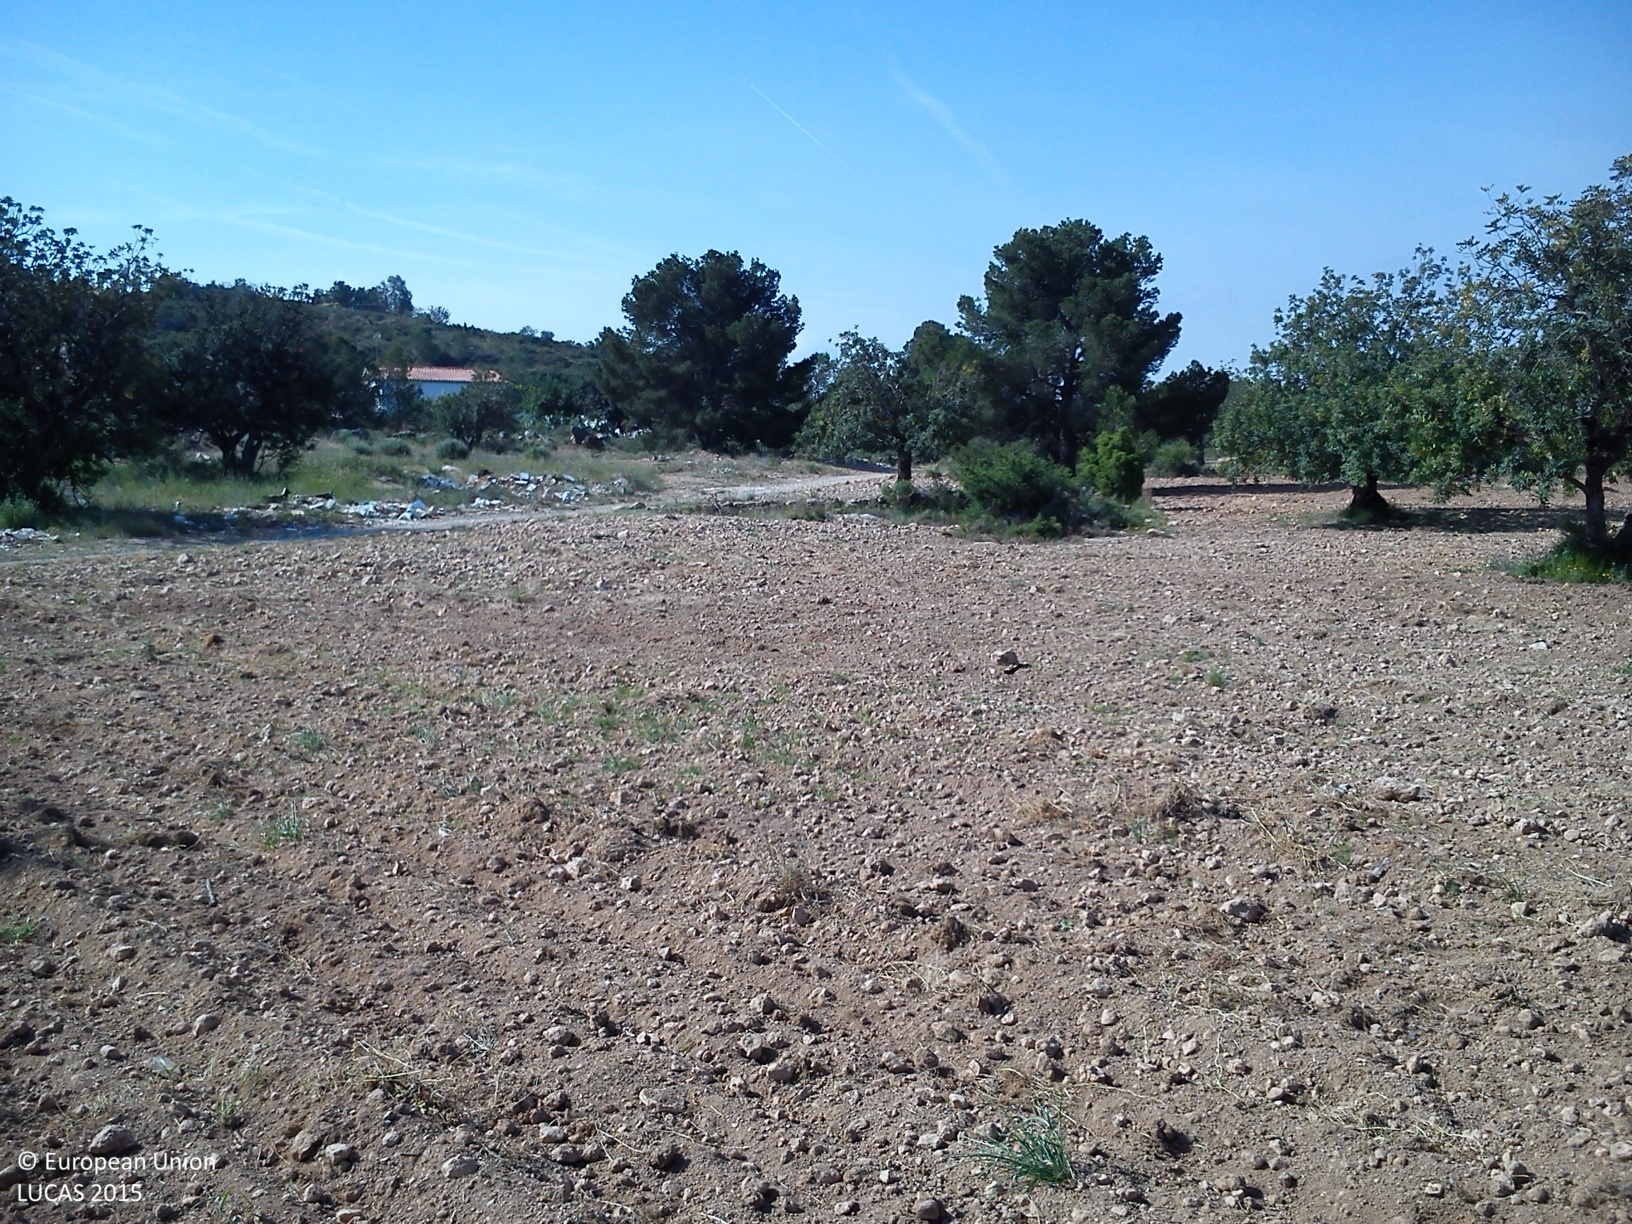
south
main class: Cropland
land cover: Permanent industrial crops
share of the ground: 10 - 25 %
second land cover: Other bare soil
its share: > 75 %
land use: Agriculture (excluding fallow land and kitchen gardens)
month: April
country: ES
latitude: 39.5993
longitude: -0.6088
